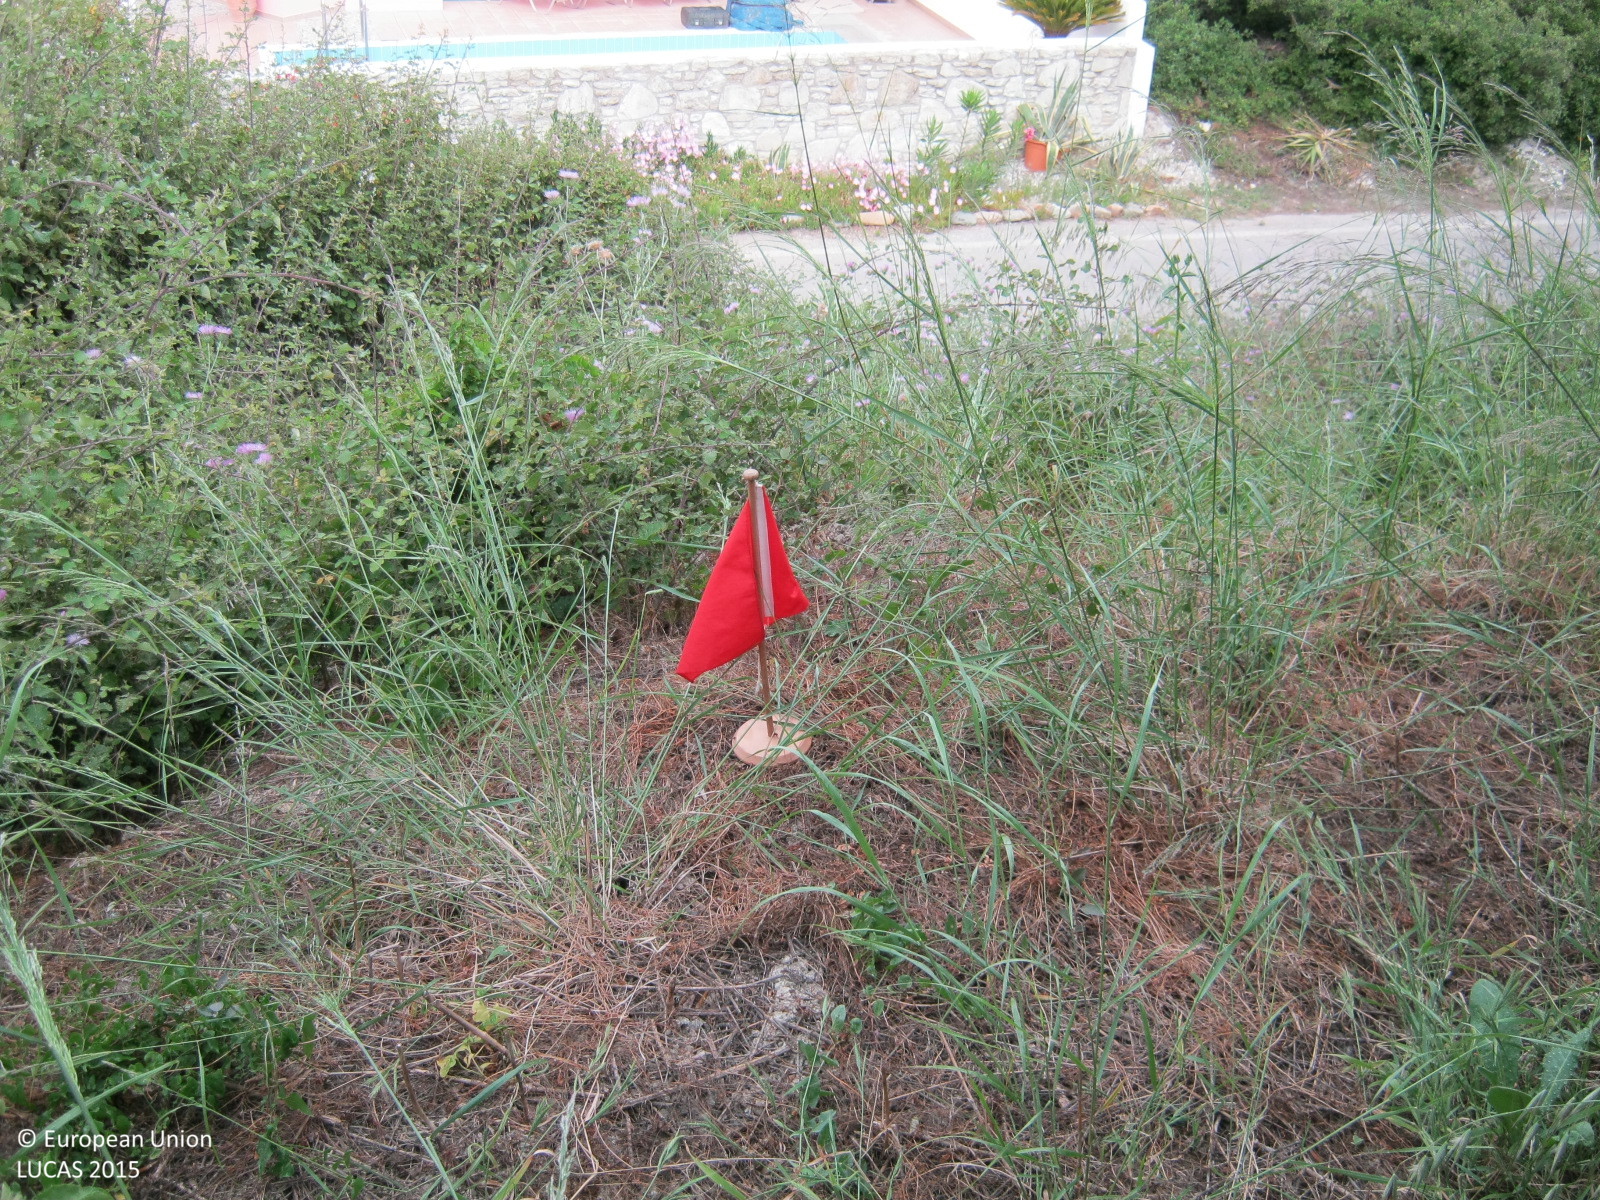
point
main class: Cropland
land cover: Olive groves
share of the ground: > 75 %
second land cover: Spontaneously vegetated surfaces
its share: > 75 %
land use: Agriculture (excluding fallow land and kitchen gardens)
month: May
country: GR
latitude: 35.4867
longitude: 23.7949
